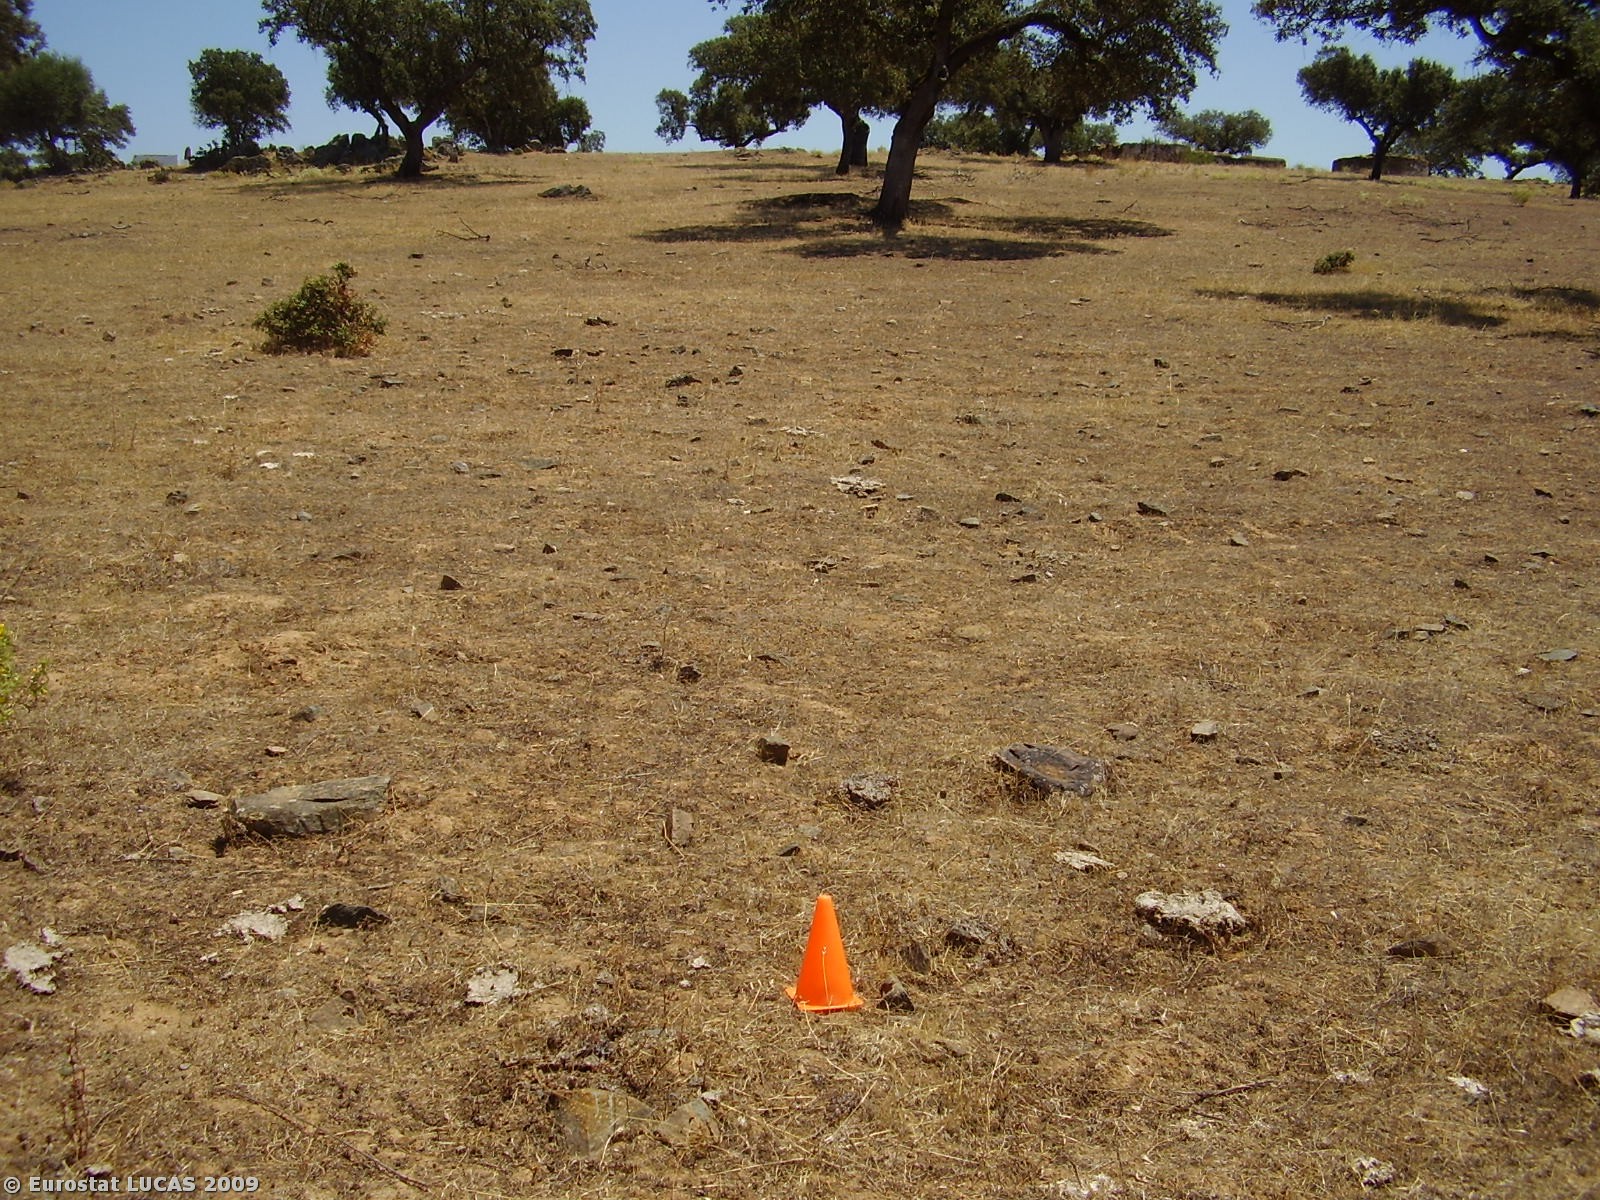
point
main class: Grassland
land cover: Grassland with sparse tree/shrub cover
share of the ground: > 75 %
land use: Fallow land
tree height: > 5 m
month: July
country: PT
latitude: 38.8285
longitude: -7.2969
